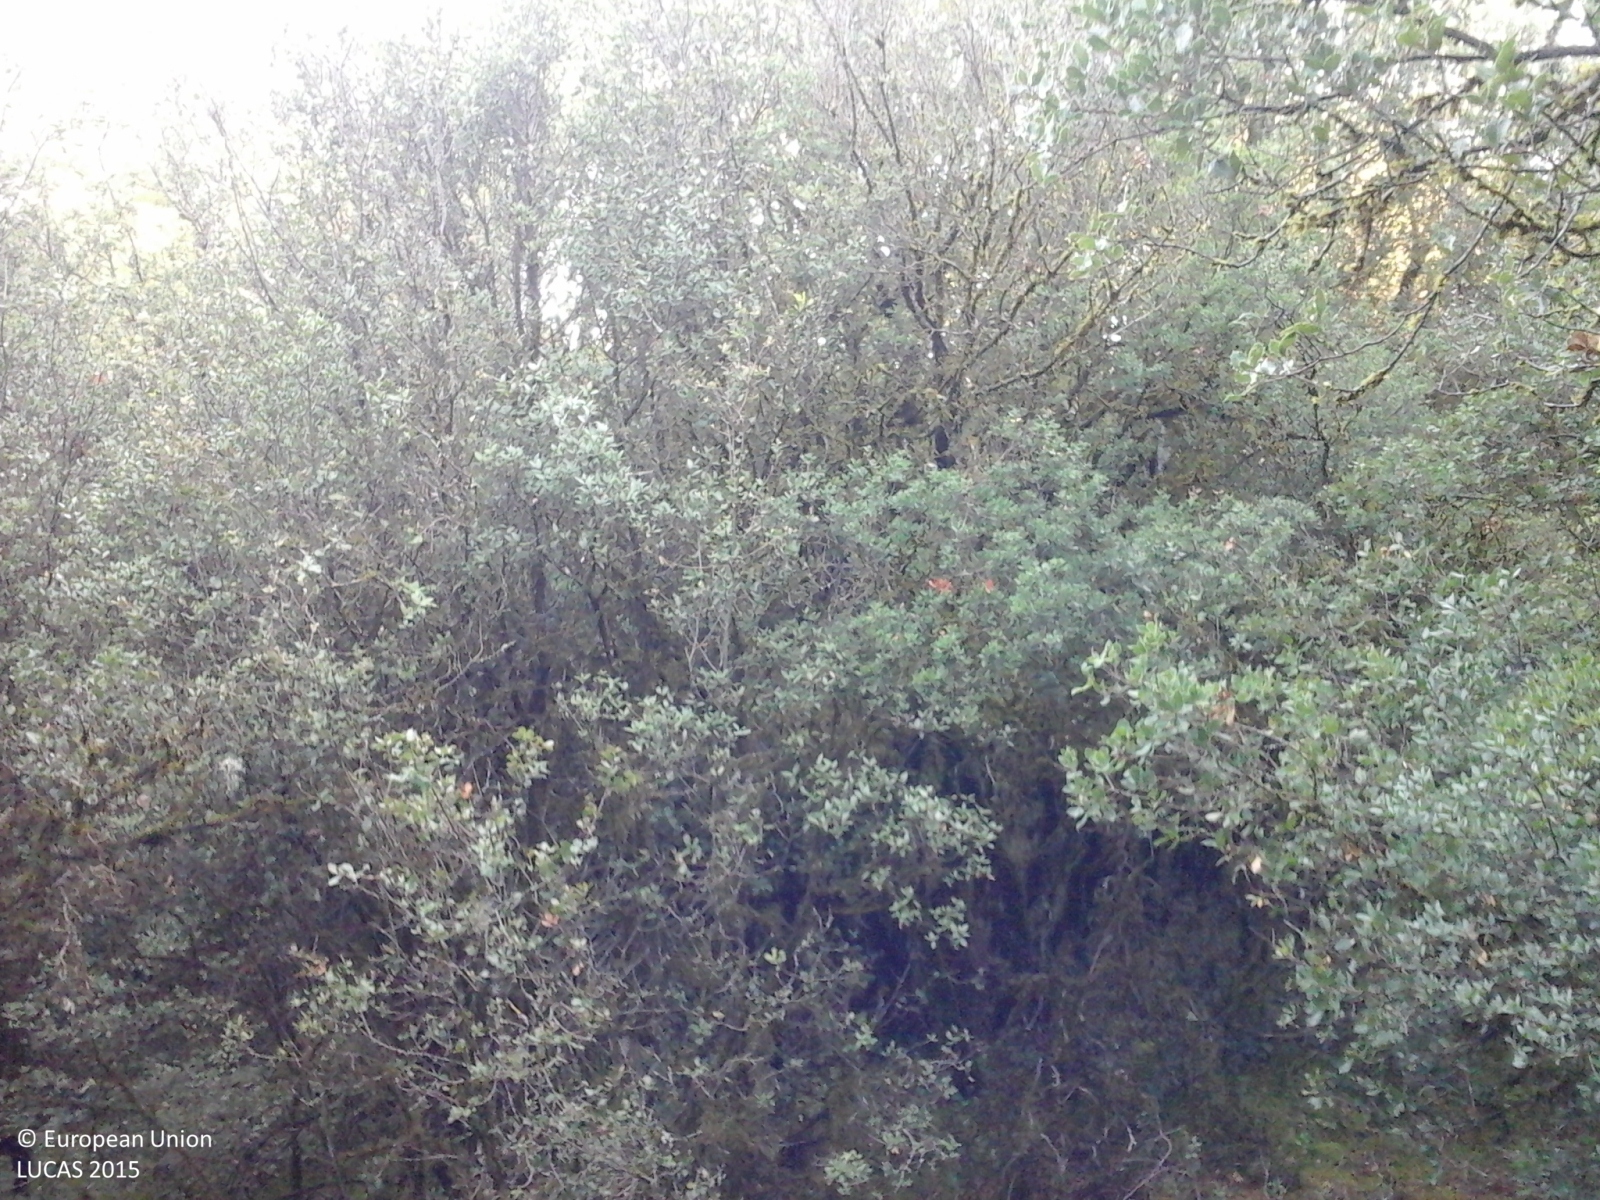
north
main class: Woodland
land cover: Broadleaved woodland
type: broadleaved evergreen forest
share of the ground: 50 - 75 %
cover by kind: broadleaved forest trees 70 %, shrubs 15 %, herbaceous plants 15 %
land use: Semi-natural and natural areas not in use
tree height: > 5 m
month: October
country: GR
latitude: 39.5636
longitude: 20.7668
